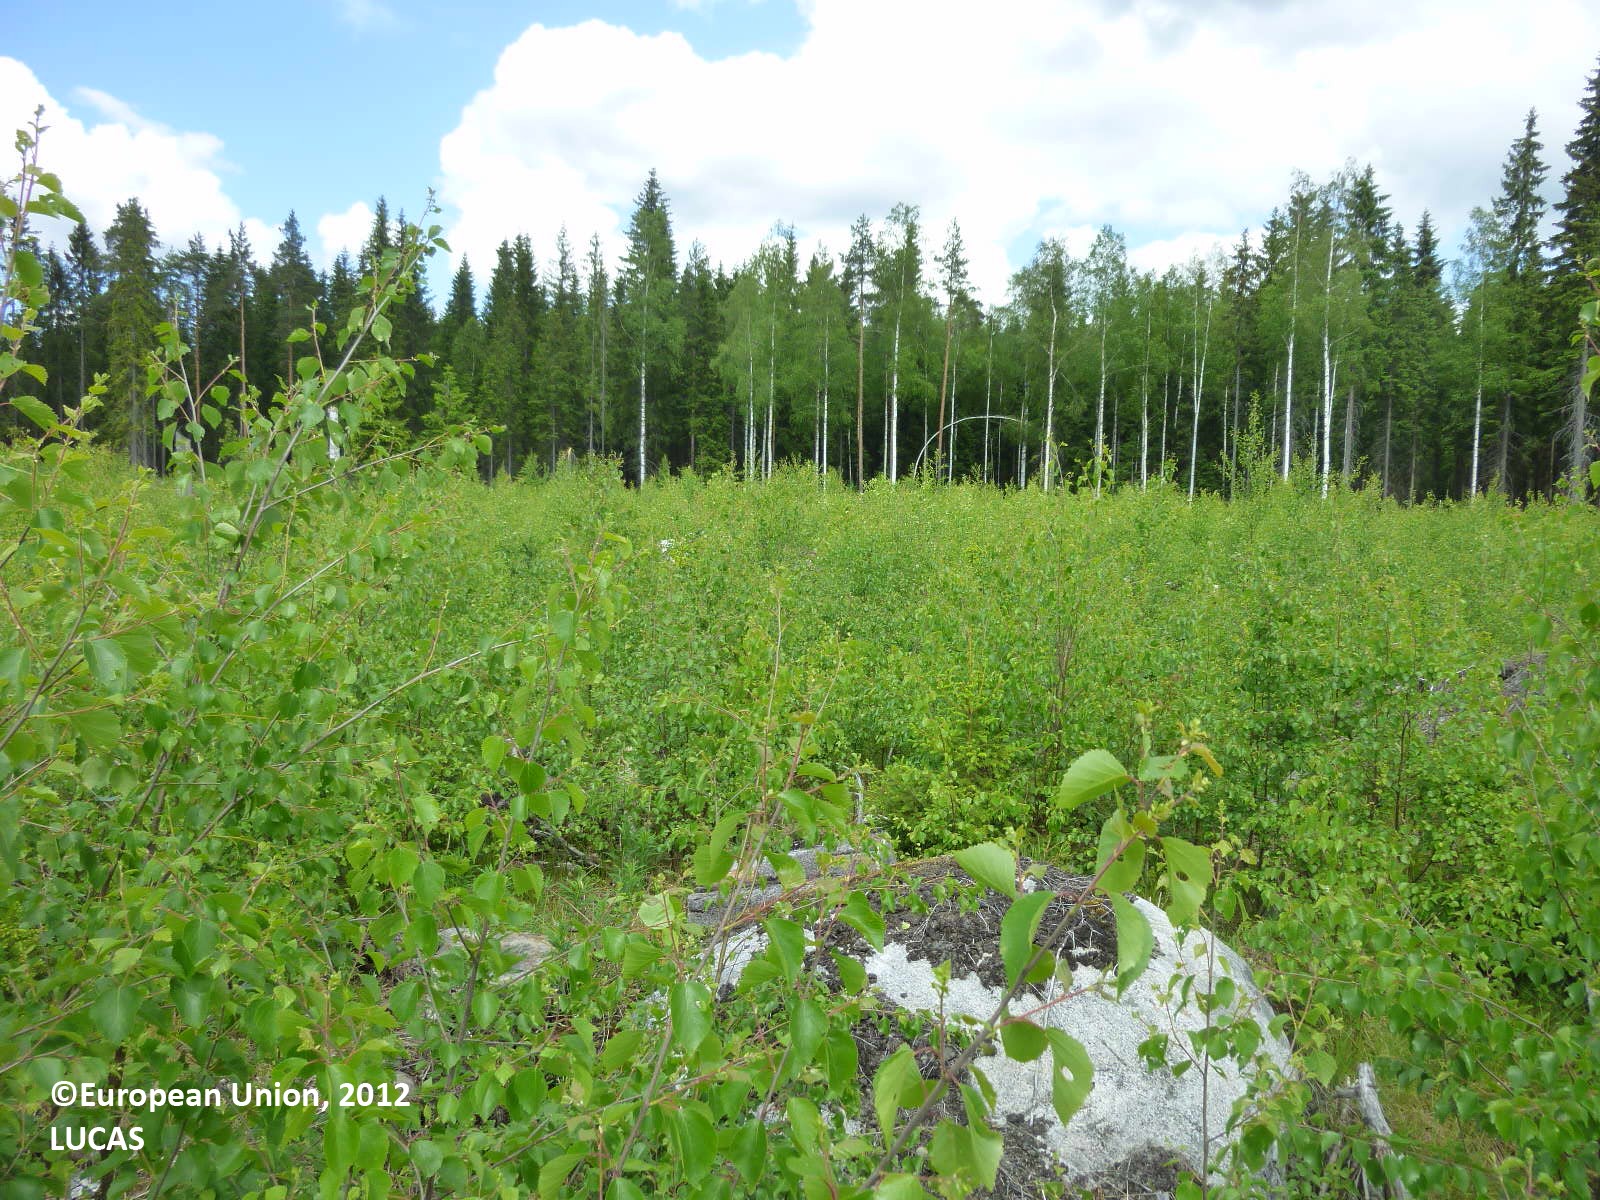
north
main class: Woodland
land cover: Broadleaved woodland
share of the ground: 50 - 75 %
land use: Forestry
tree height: > 5 m
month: June
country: FI
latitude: 61.4459
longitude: 22.5358
